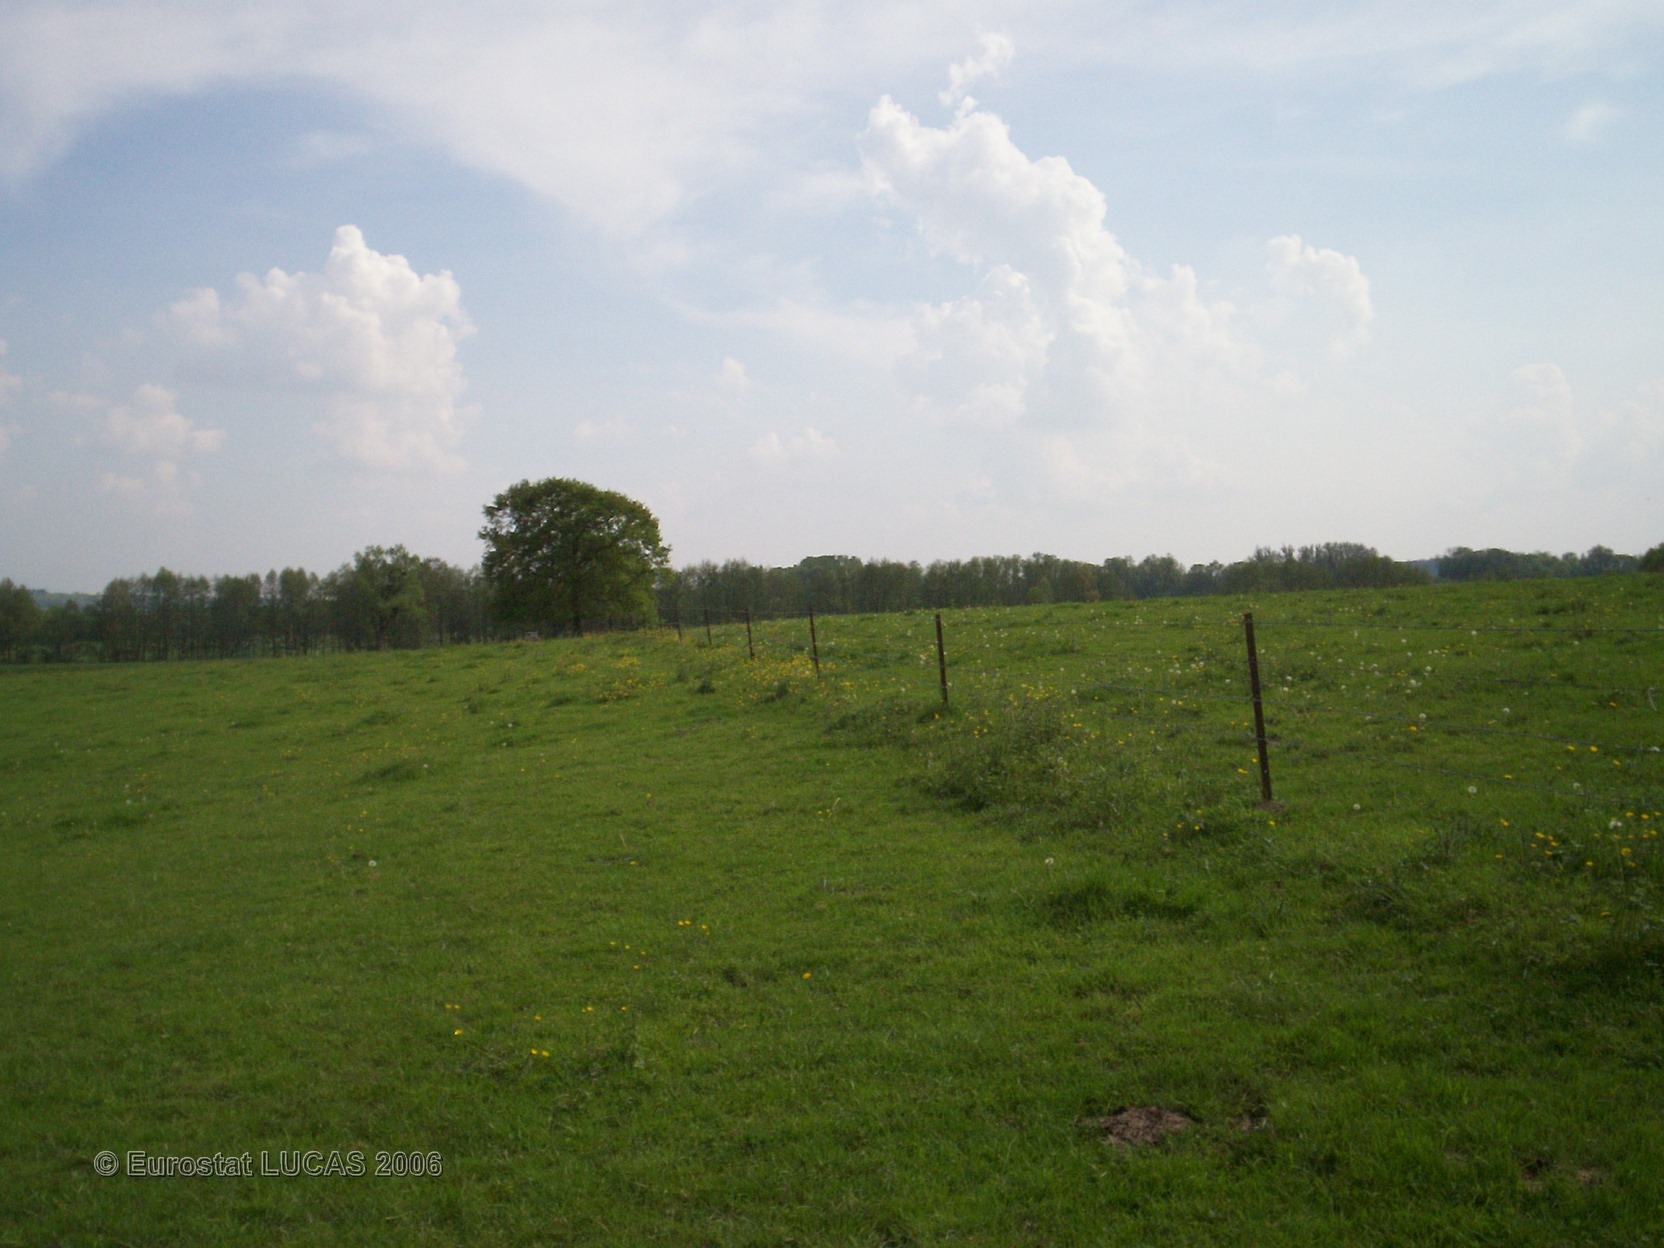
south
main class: Grassland
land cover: Grassland without tree/shrub cover
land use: Agriculture (excluding fallow land and kitchen gardens)
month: May
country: FR
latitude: 49.6273
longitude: 4.3057
